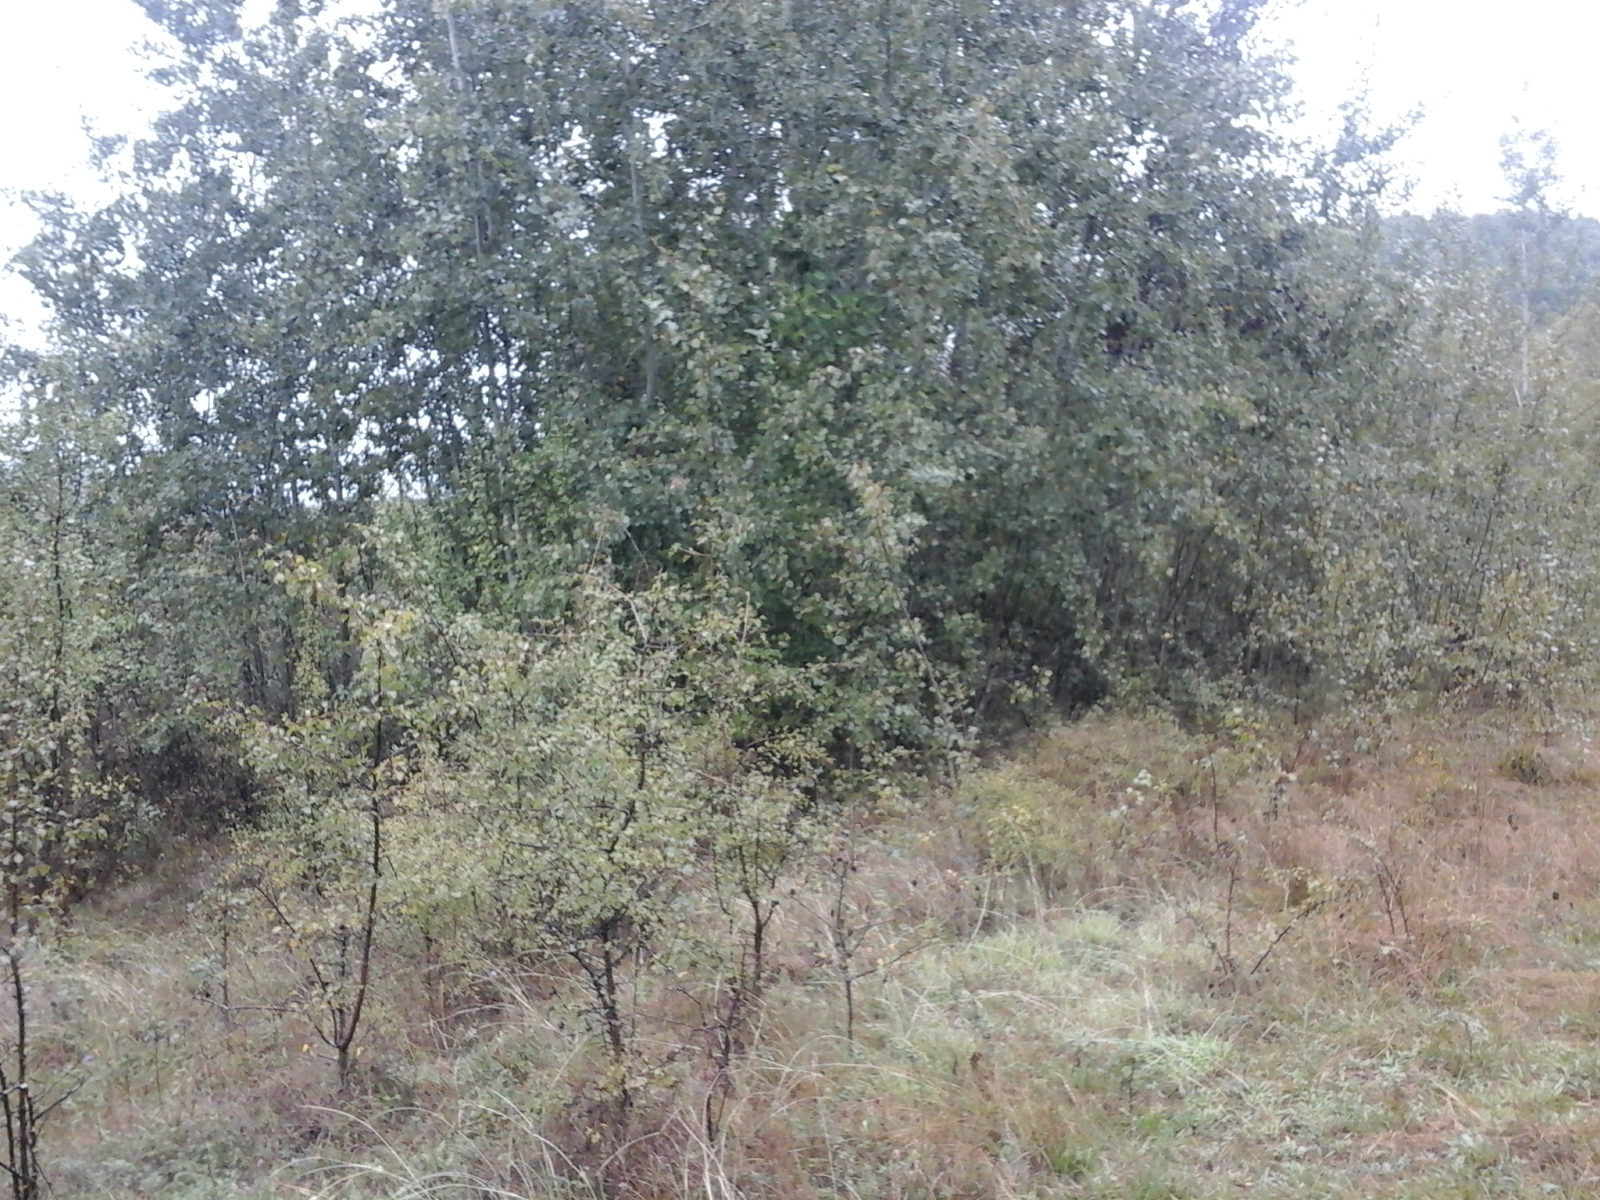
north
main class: Grassland
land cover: Grassland with sparse tree/shrub cover
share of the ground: > 75 %
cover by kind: herbaceous plants 85 %, shrubs 10 %, broadleaved forest trees 5 %
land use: Fallow land
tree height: < 5 m
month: September
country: RO
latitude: 44.8844
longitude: 23.6692
